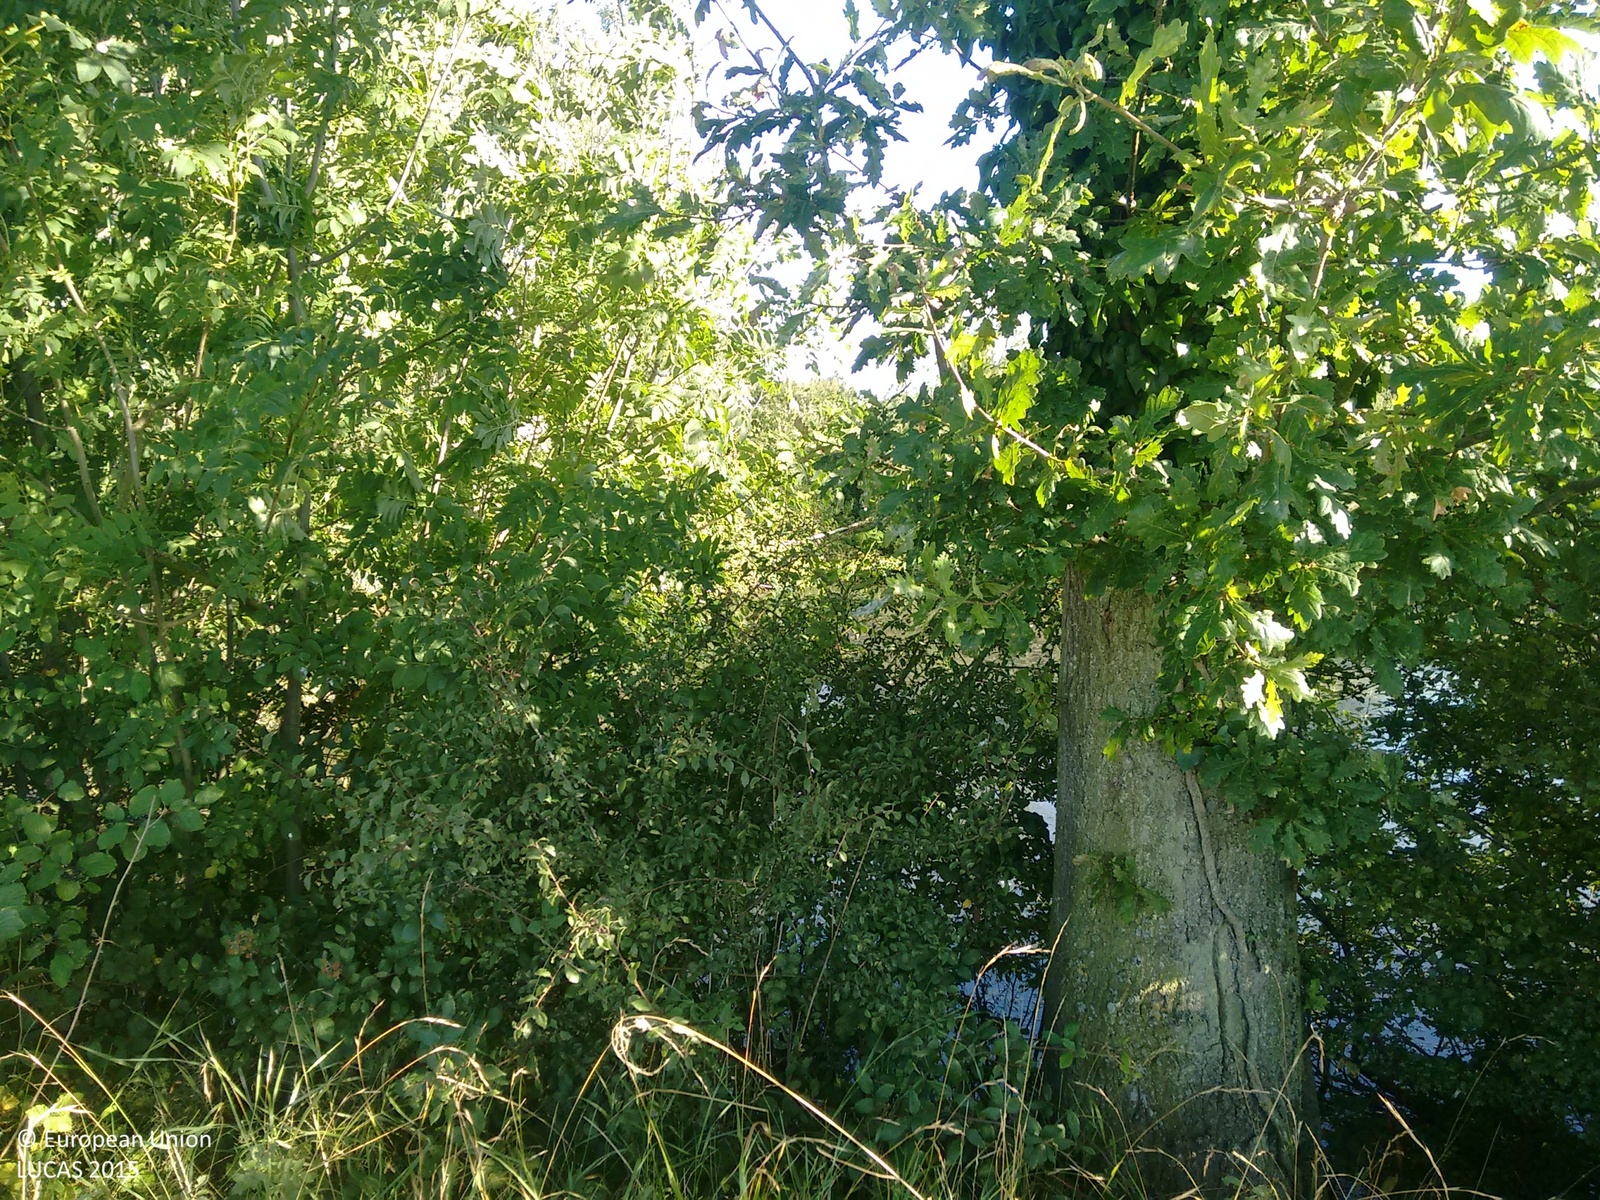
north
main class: Grassland
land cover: Grassland without tree/shrub cover
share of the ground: > 75 %
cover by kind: herbaceous plants 80 %, unconsolidated bare surface 20 %
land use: Agriculture (excluding fallow land and kitchen gardens)
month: September
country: GB
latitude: 52.2467
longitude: 1.4119
